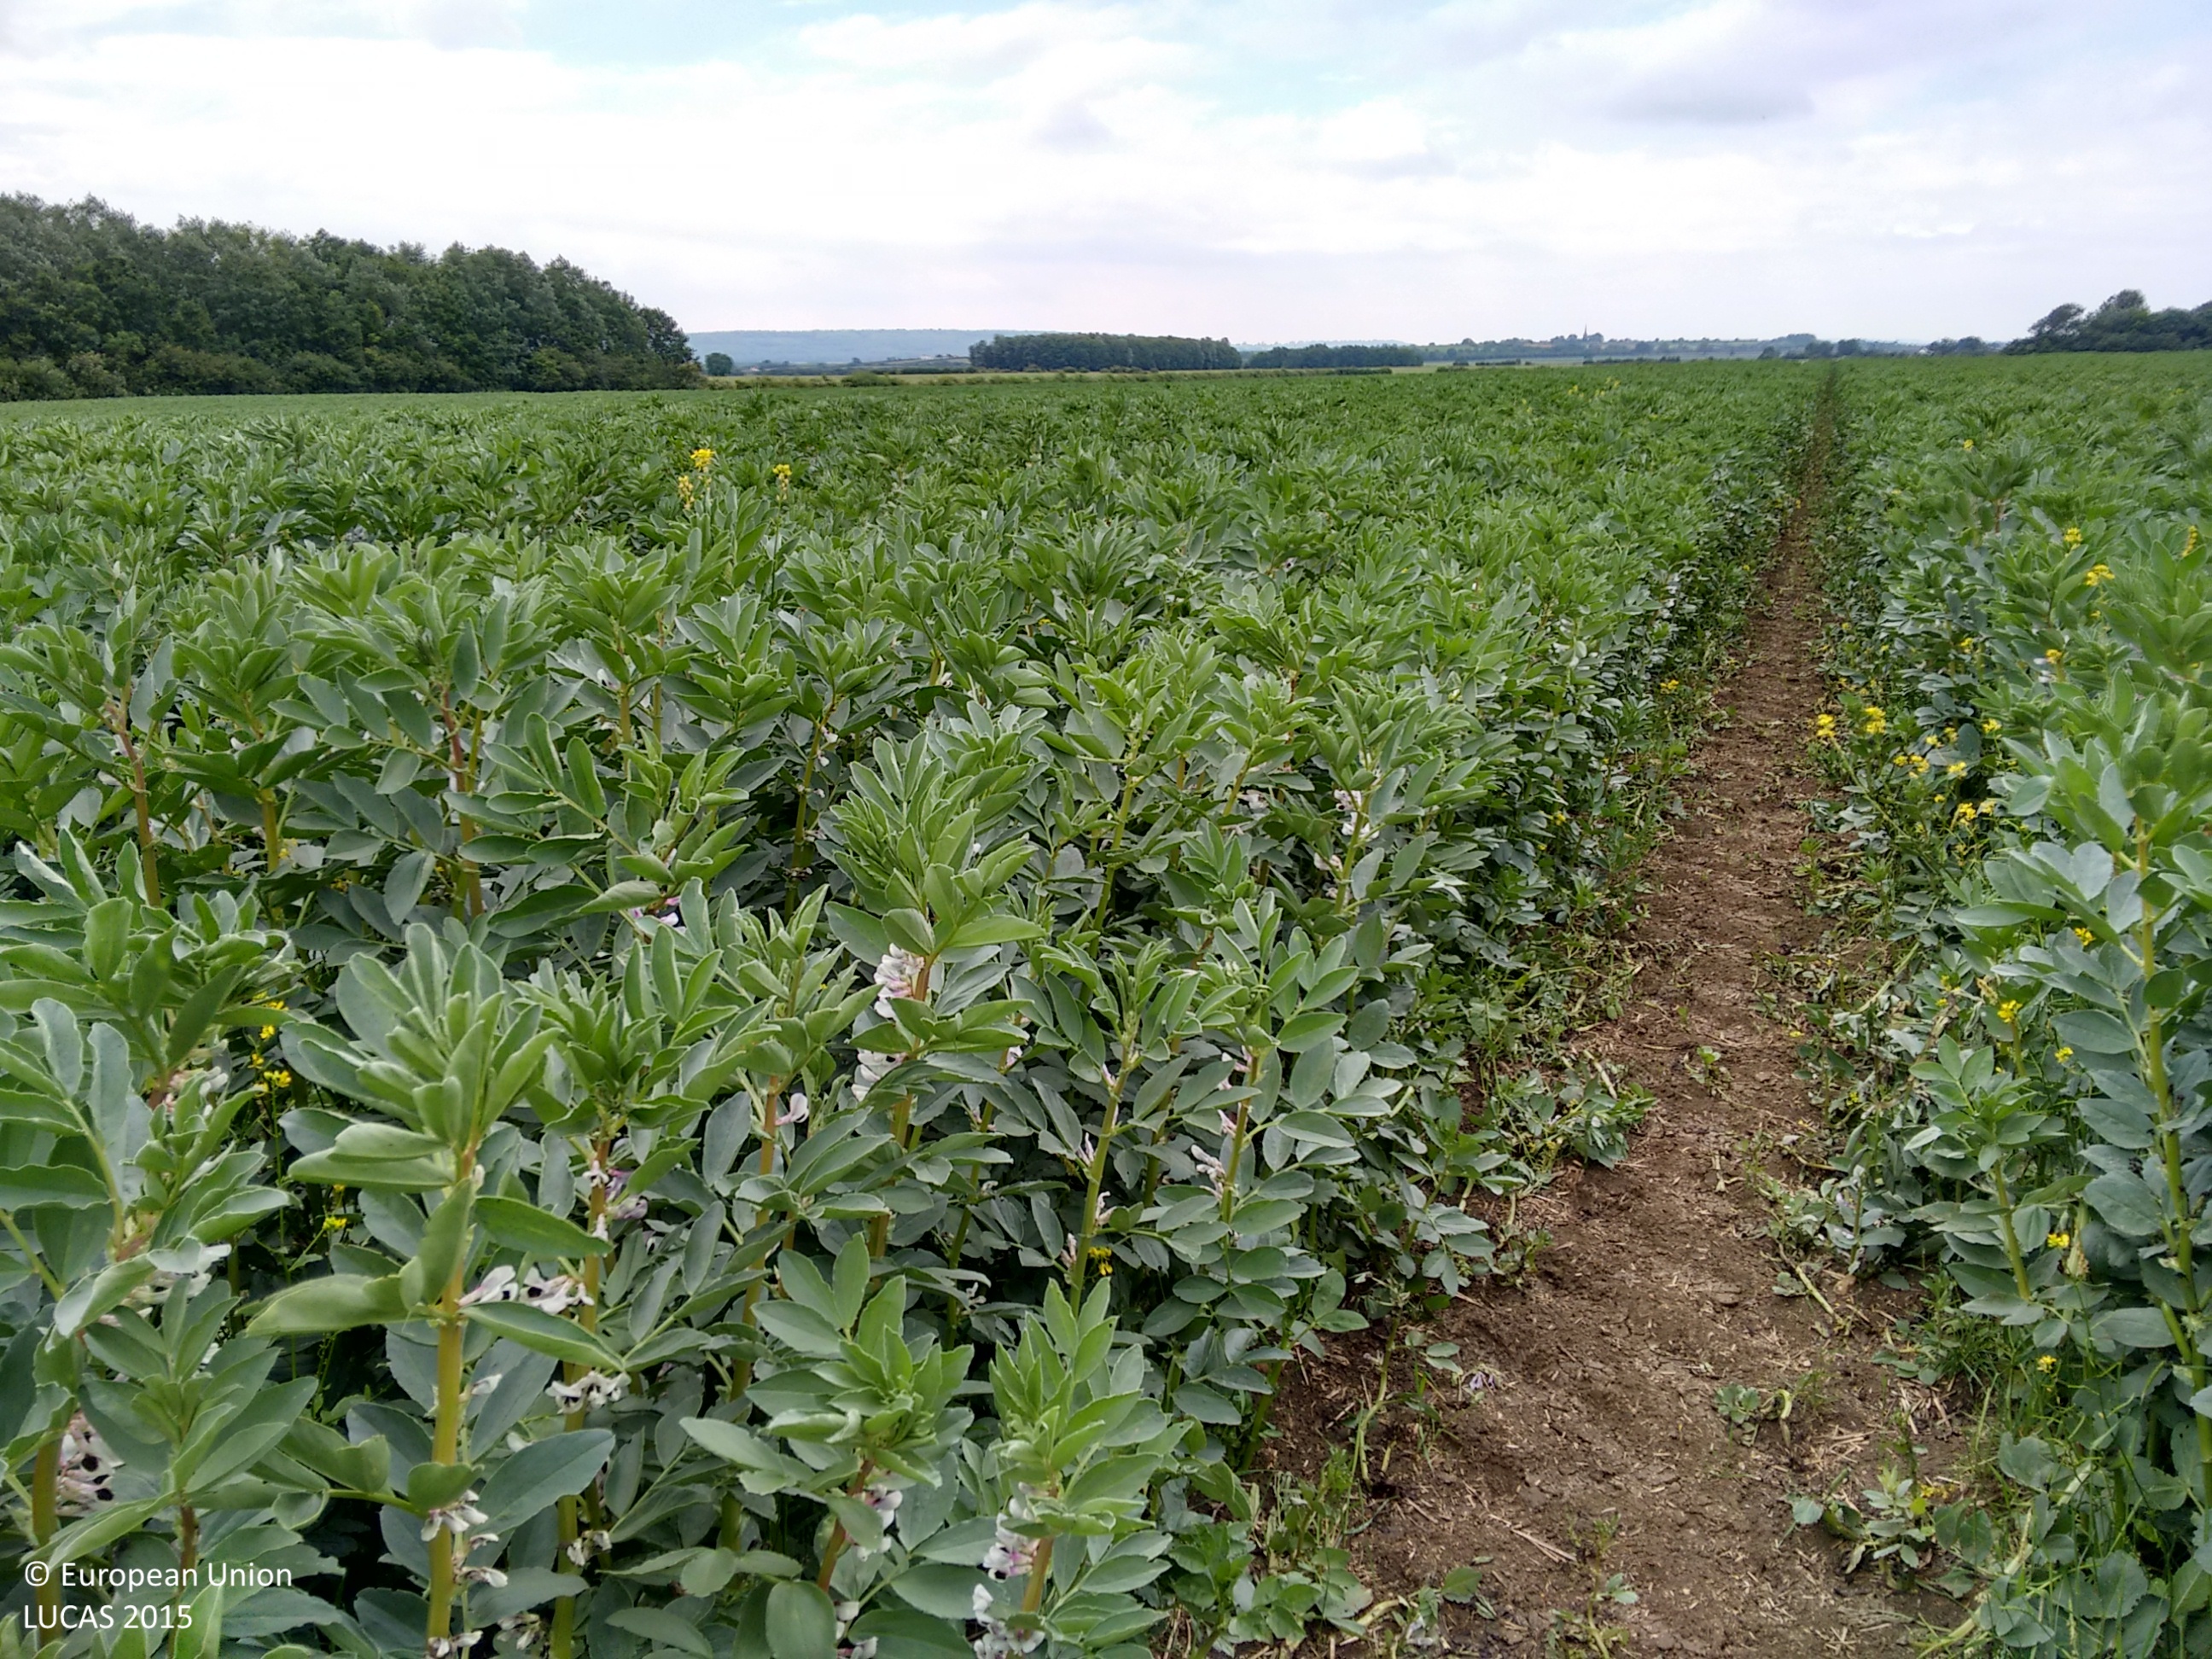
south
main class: Cropland
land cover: Dry pulses
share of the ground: > 75 %
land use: Agriculture (excluding fallow land and kitchen gardens)
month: June
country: GB
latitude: 52.9330
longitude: -0.8280
